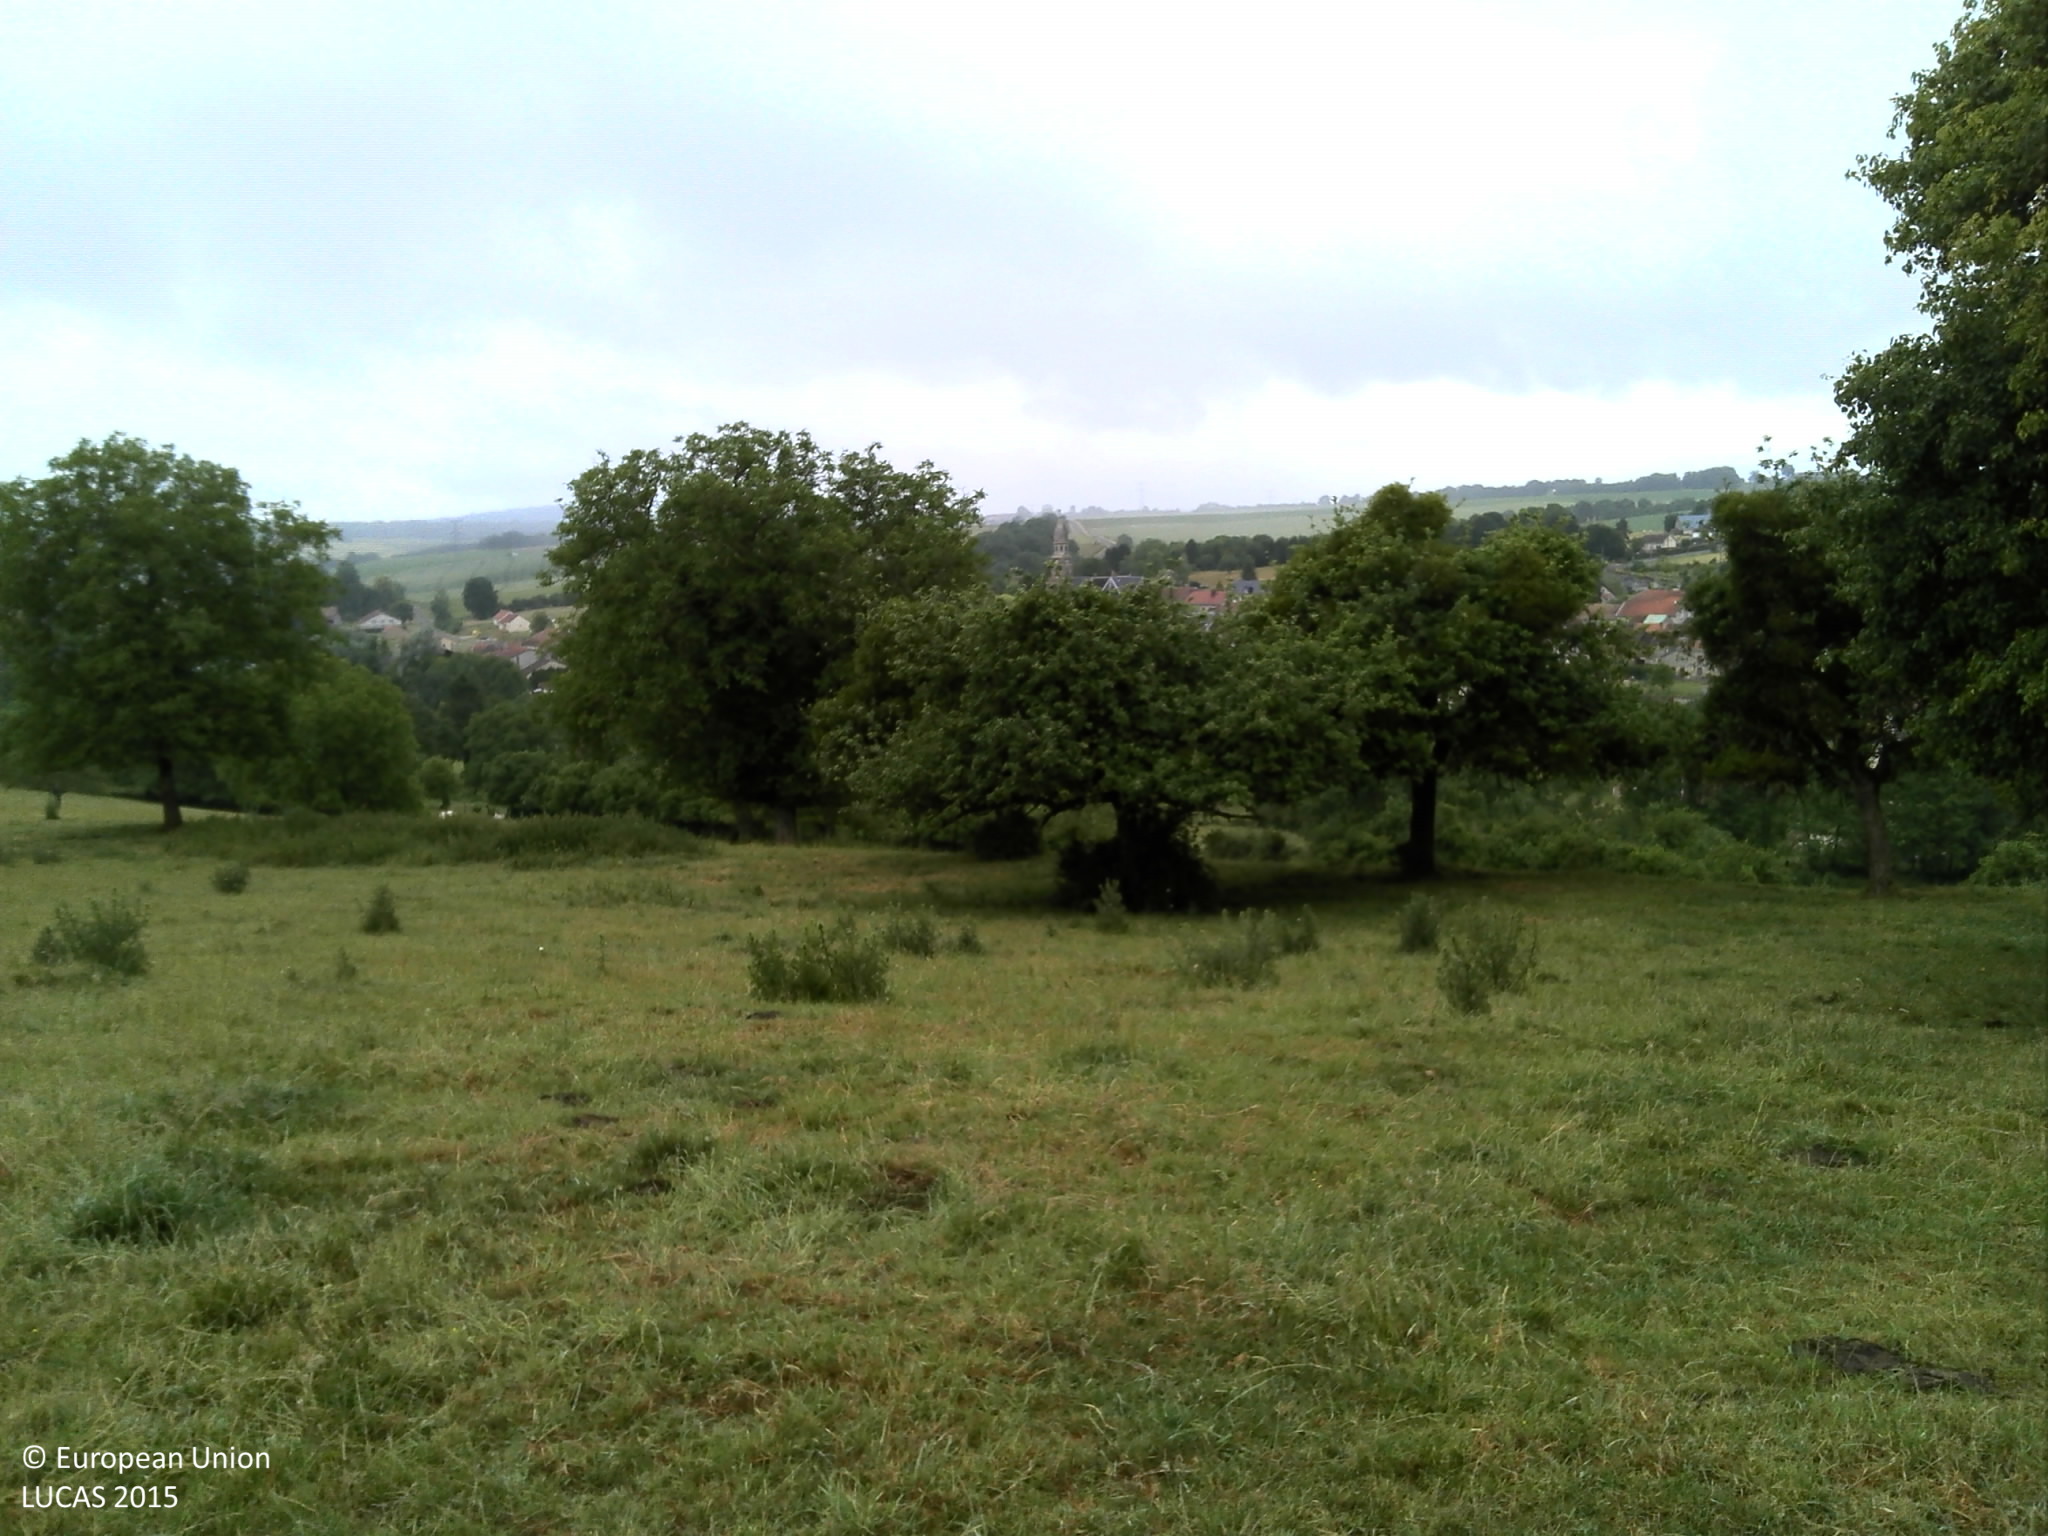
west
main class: Cropland
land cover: Maize
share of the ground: > 75 %
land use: Agriculture (excluding fallow land and kitchen gardens)
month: June
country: FR
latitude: 49.5369
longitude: 5.0645
